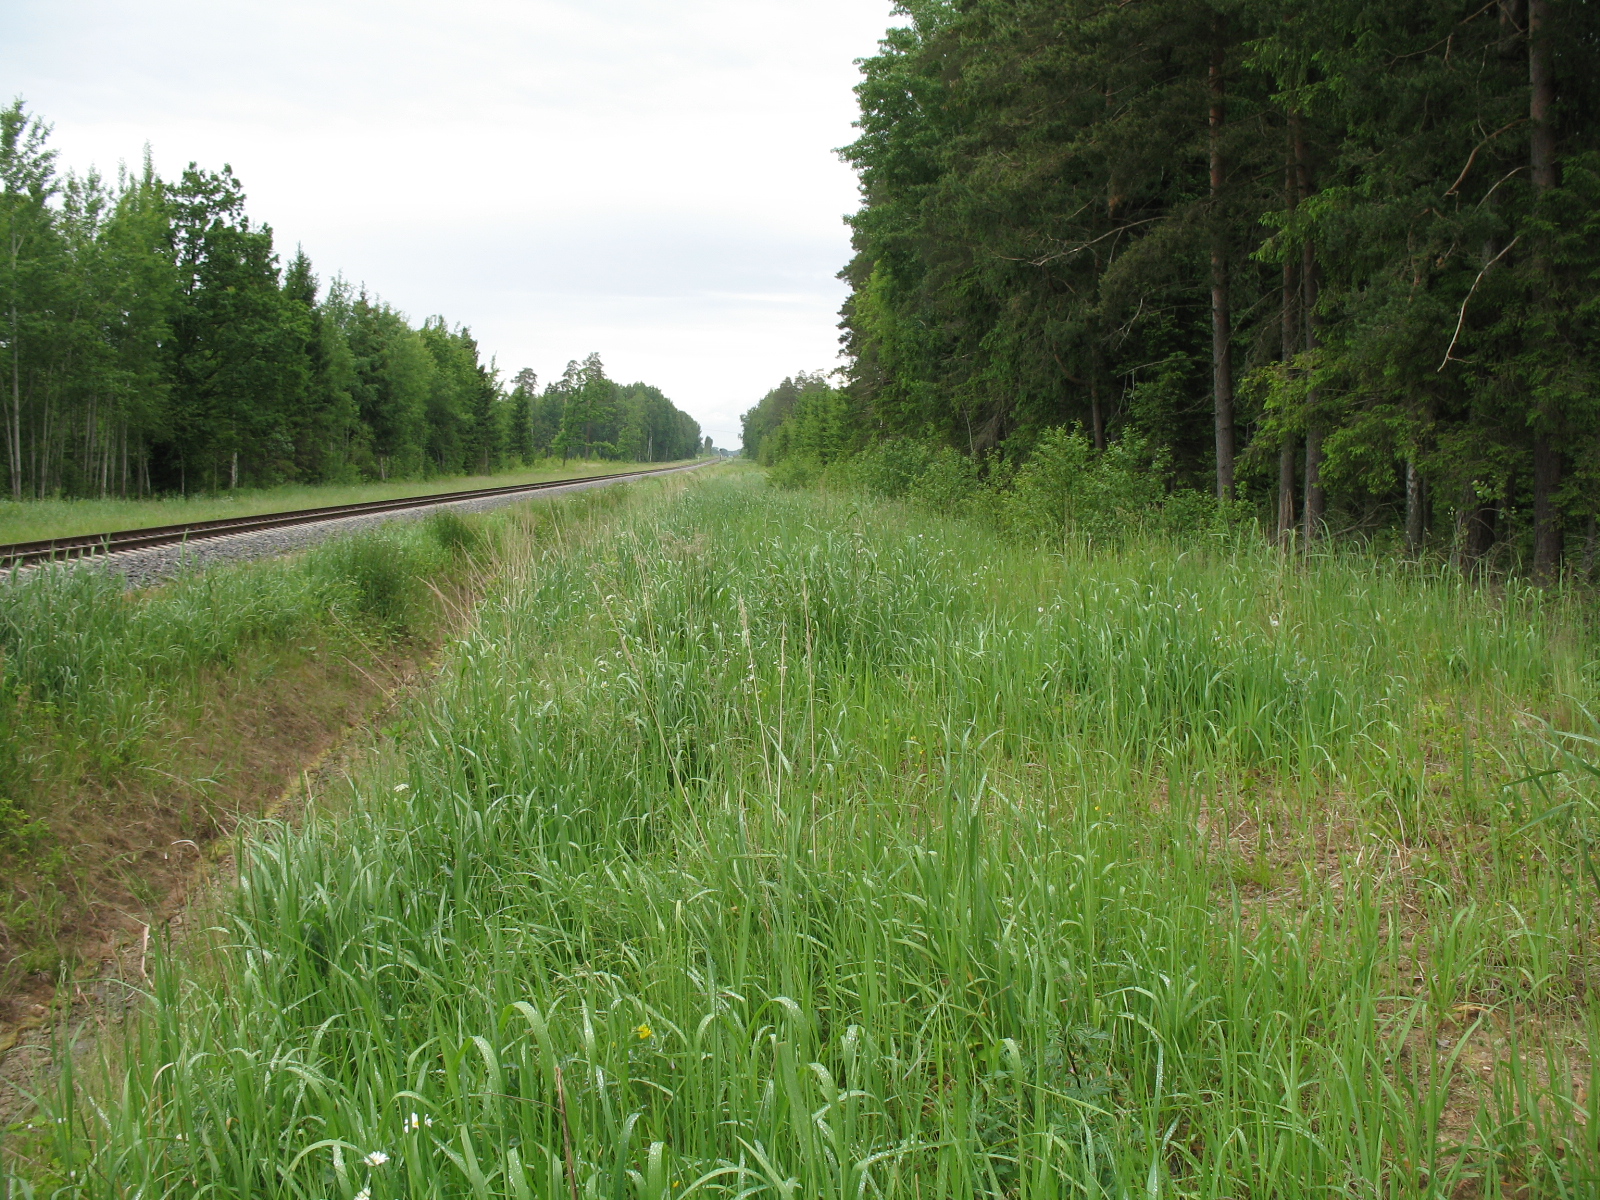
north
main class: Grassland
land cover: Spontaneously vegetated surfaces
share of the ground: 50 - 75 %
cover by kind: herbaceous plants 60 %, unconsolidated bare surface 40 %
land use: Railway transport
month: June
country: LV
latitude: 56.3835
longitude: 23.6670
